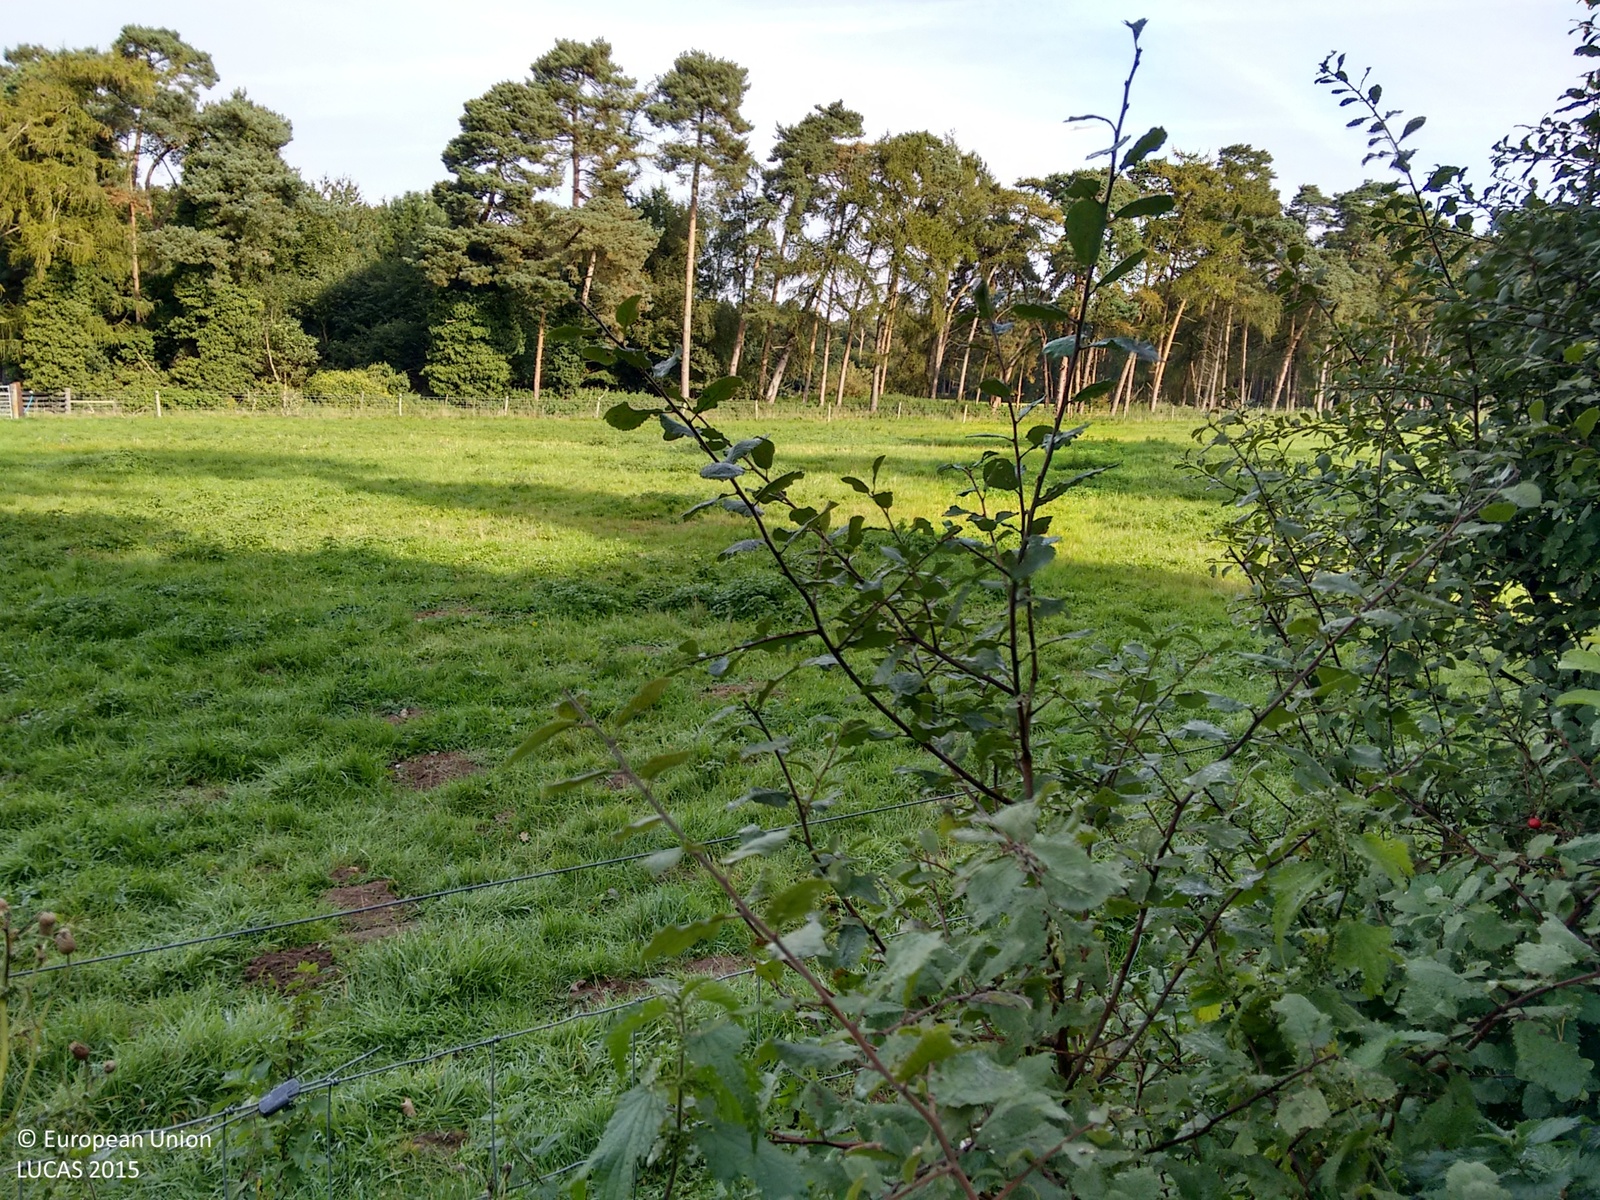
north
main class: Grassland
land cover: Grassland without tree/shrub cover
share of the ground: > 75 %
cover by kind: herbaceous plants 100 %
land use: Agriculture (excluding fallow land and kitchen gardens)
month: September
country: GB
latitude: 52.4211
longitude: 0.8441
